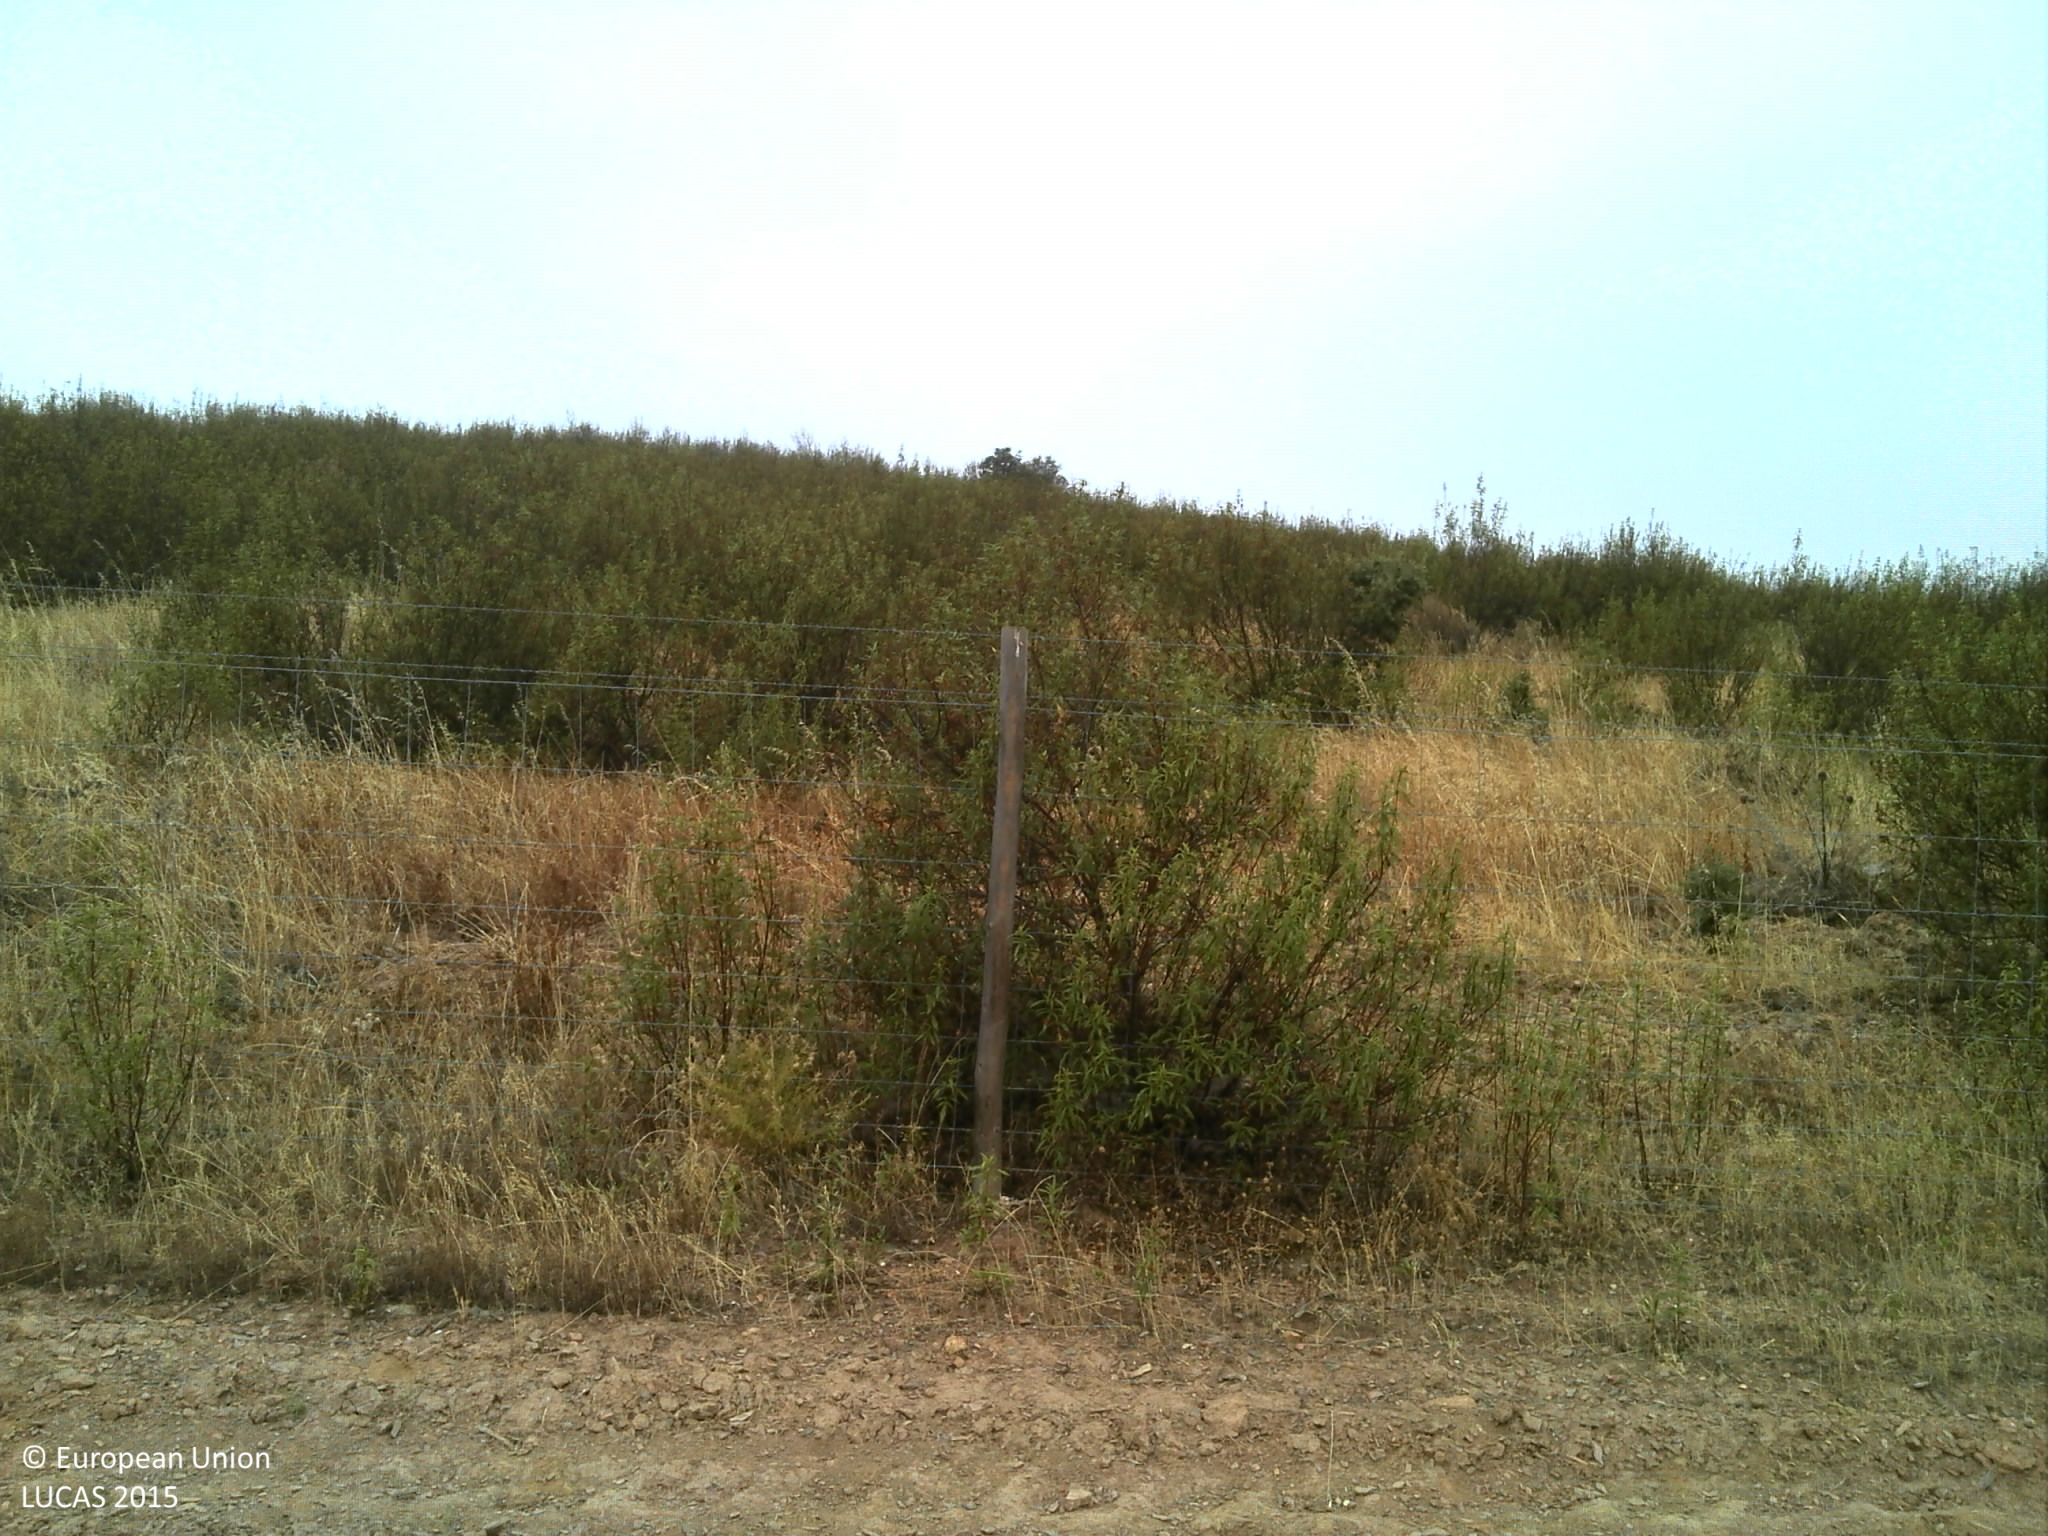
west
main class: Grassland
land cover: Grassland without tree/shrub cover
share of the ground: > 75 %
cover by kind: herbaceous plants 80 %, unconsolidated bare surface 20 %
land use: Agriculture (excluding fallow land and kitchen gardens)
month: July
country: PT
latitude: 38.4747
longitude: -7.4146
